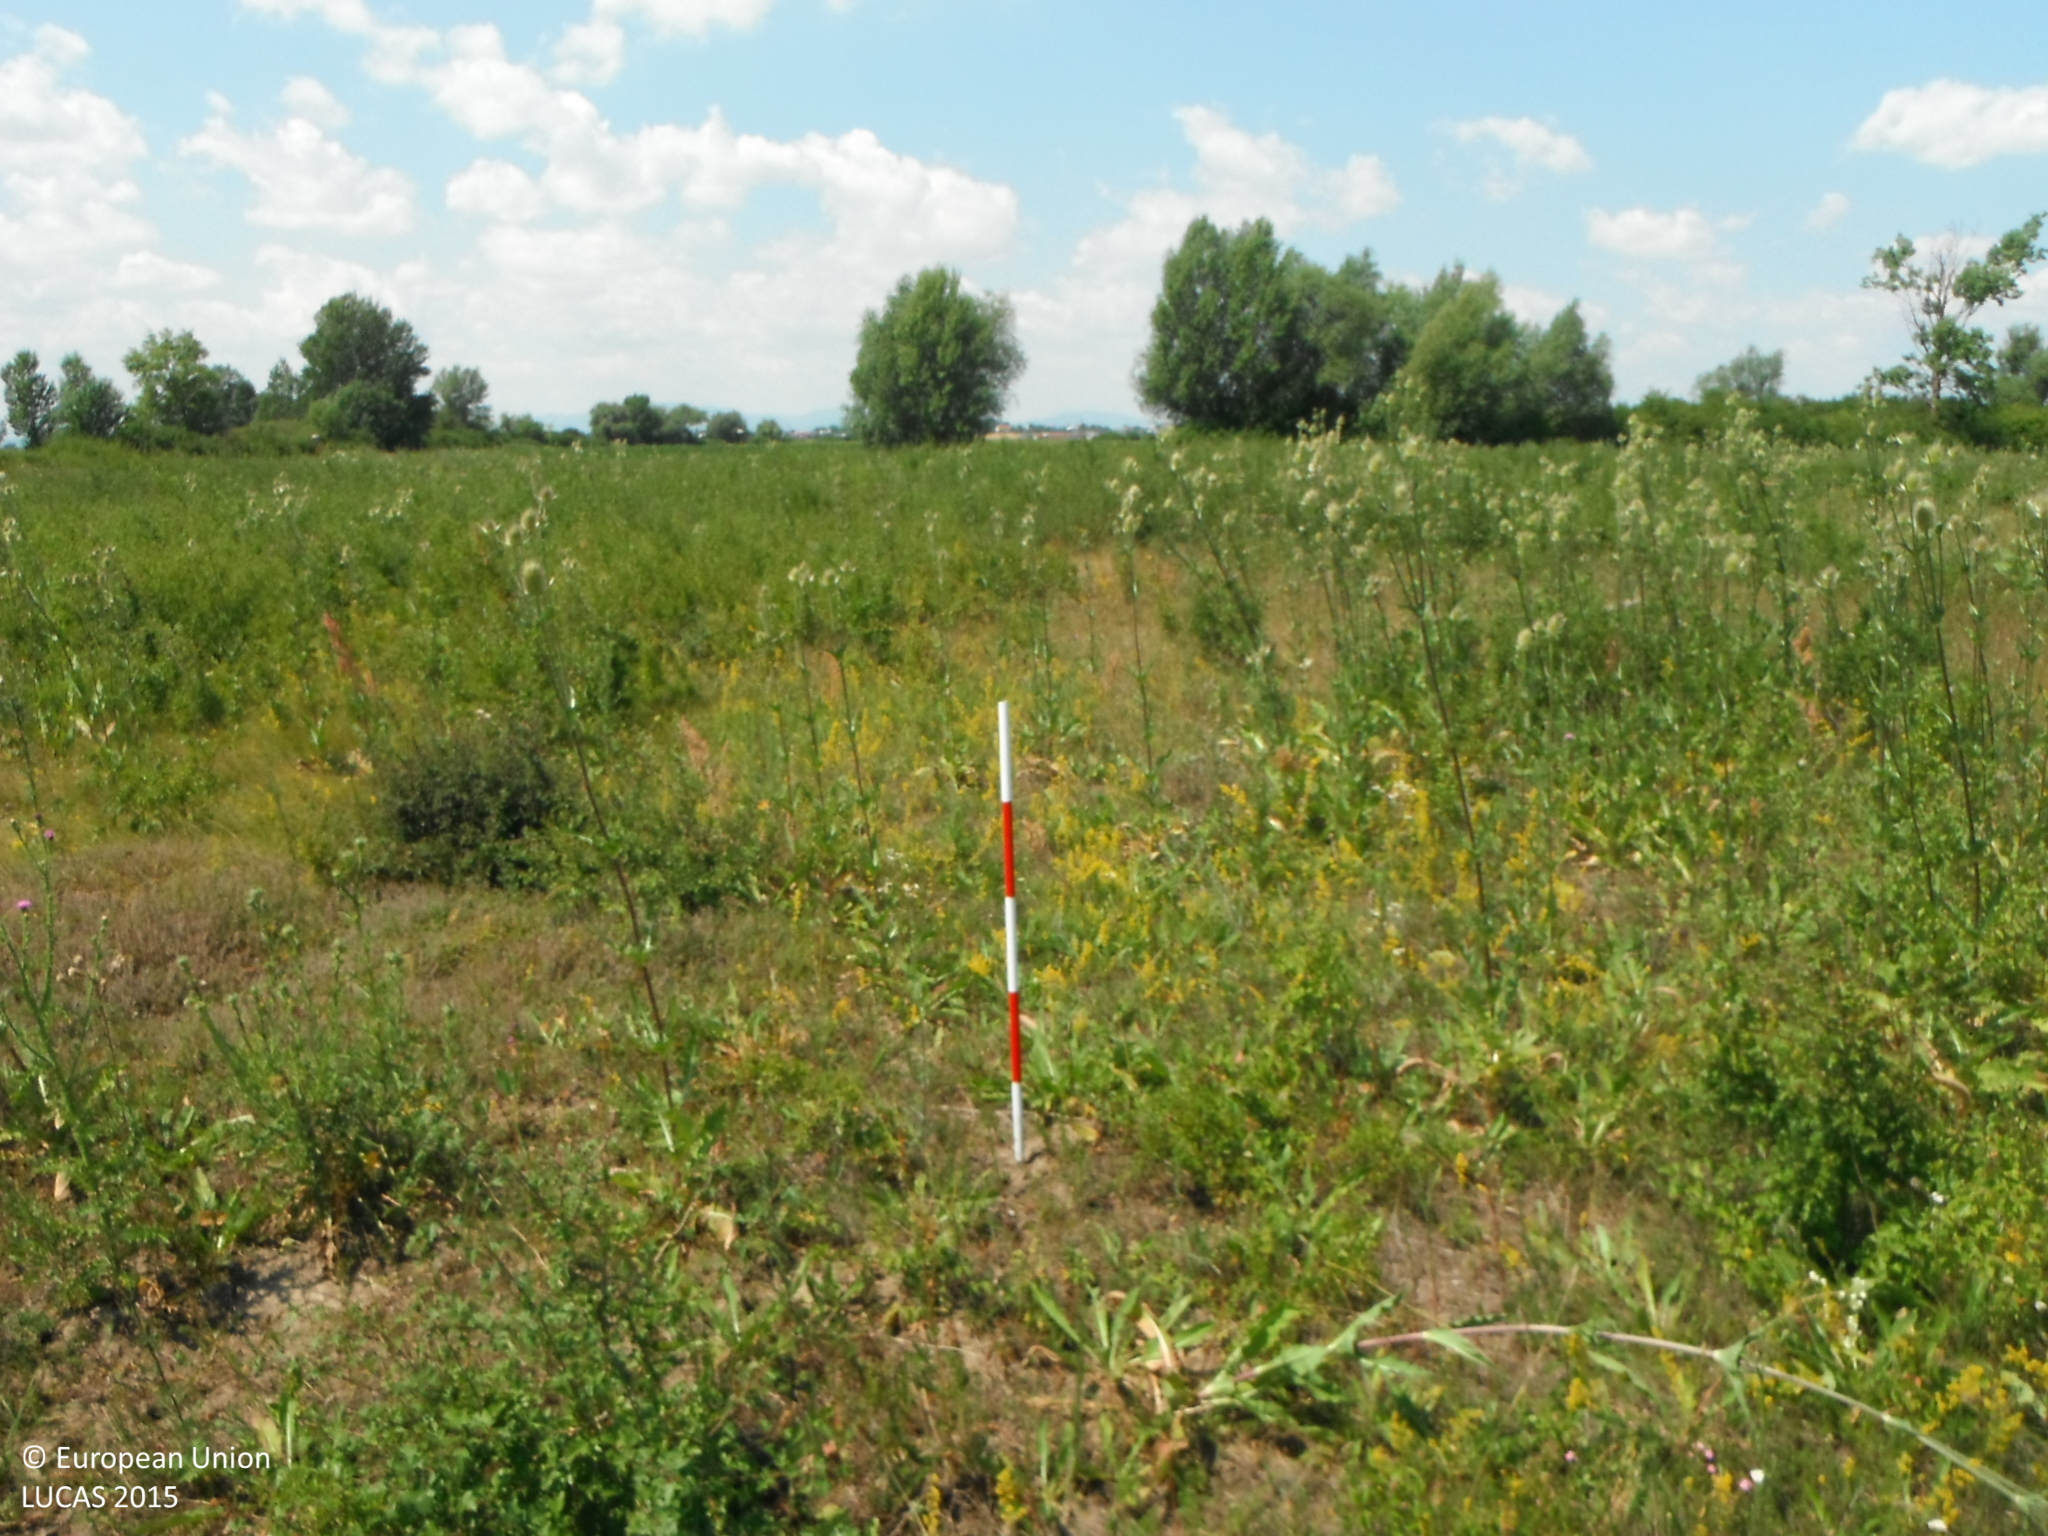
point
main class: Grassland
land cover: Spontaneously vegetated surfaces
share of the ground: > 75 %
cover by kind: herbaceous plants 100 %
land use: Agriculture (excluding fallow land and kitchen gardens)
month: July
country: SK
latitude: 48.5781
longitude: 21.8858
